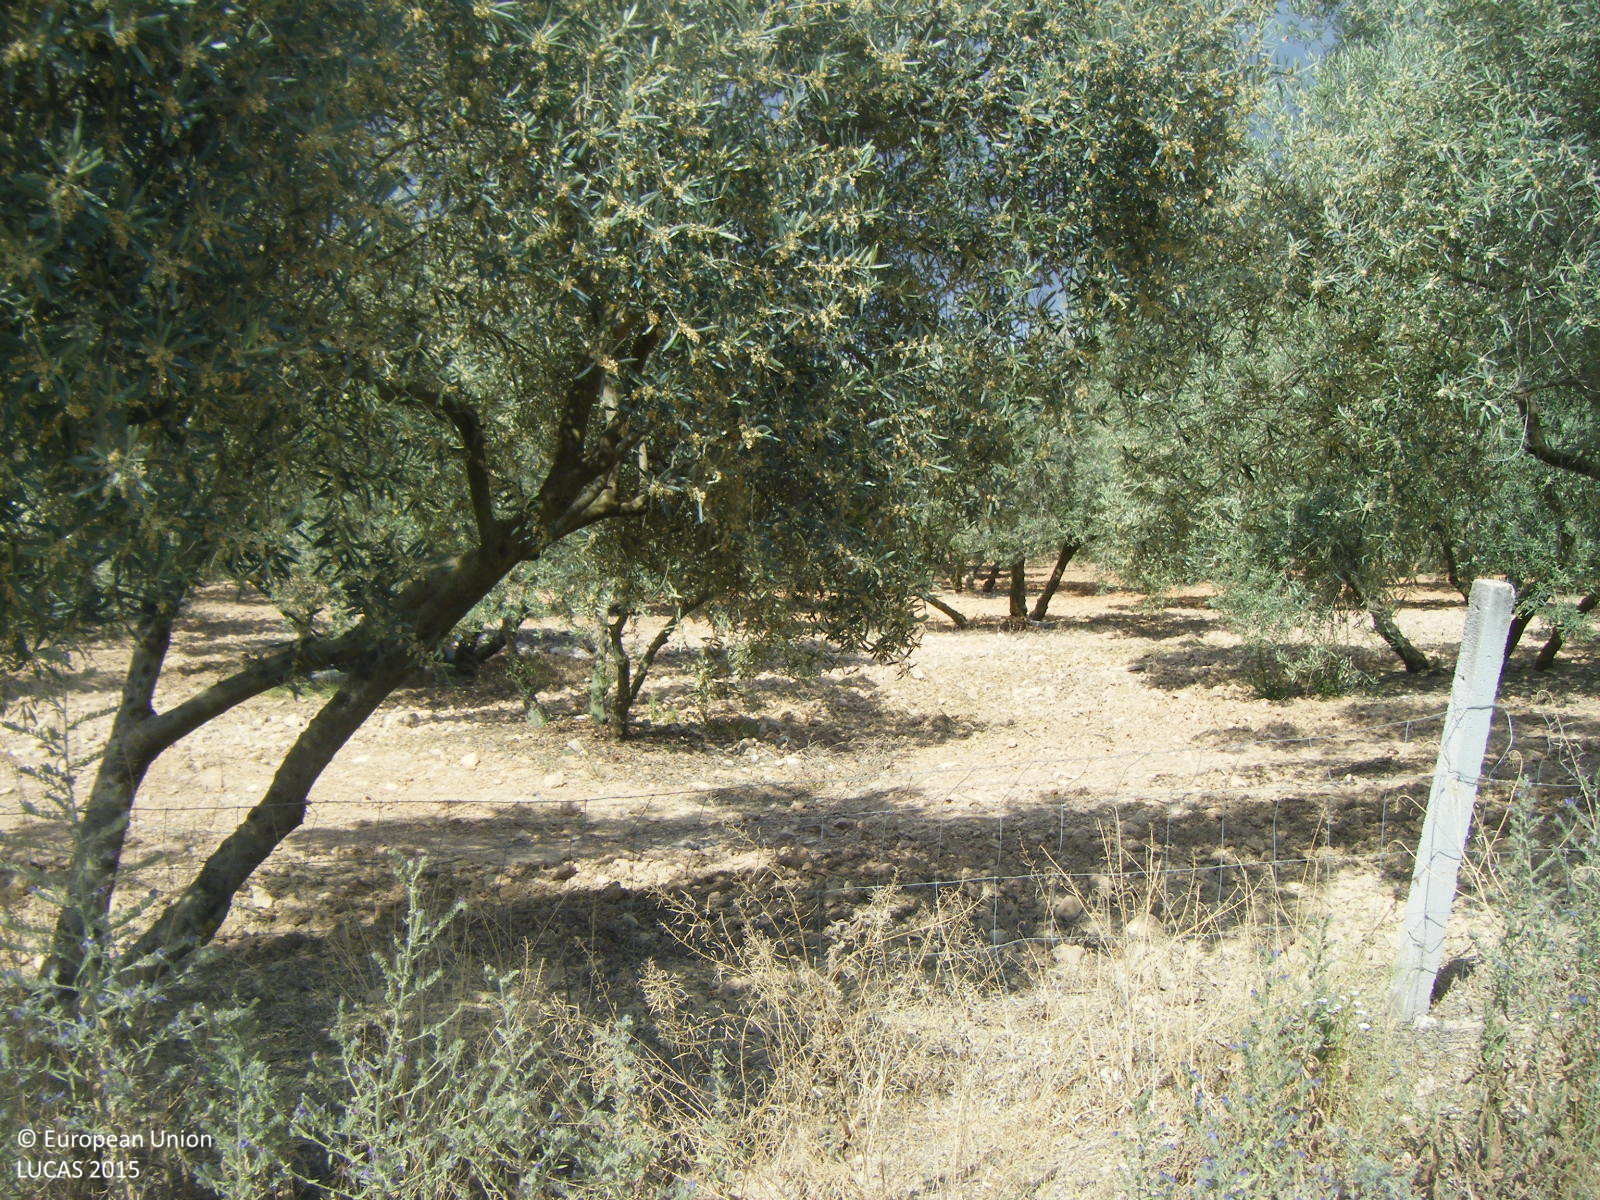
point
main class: Cropland
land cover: Olive groves
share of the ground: 10 - 25 %
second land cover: Other bare soil
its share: > 75 %
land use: Agriculture (excluding fallow land and kitchen gardens)
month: May
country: ES
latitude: 37.1246
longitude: -4.3923
